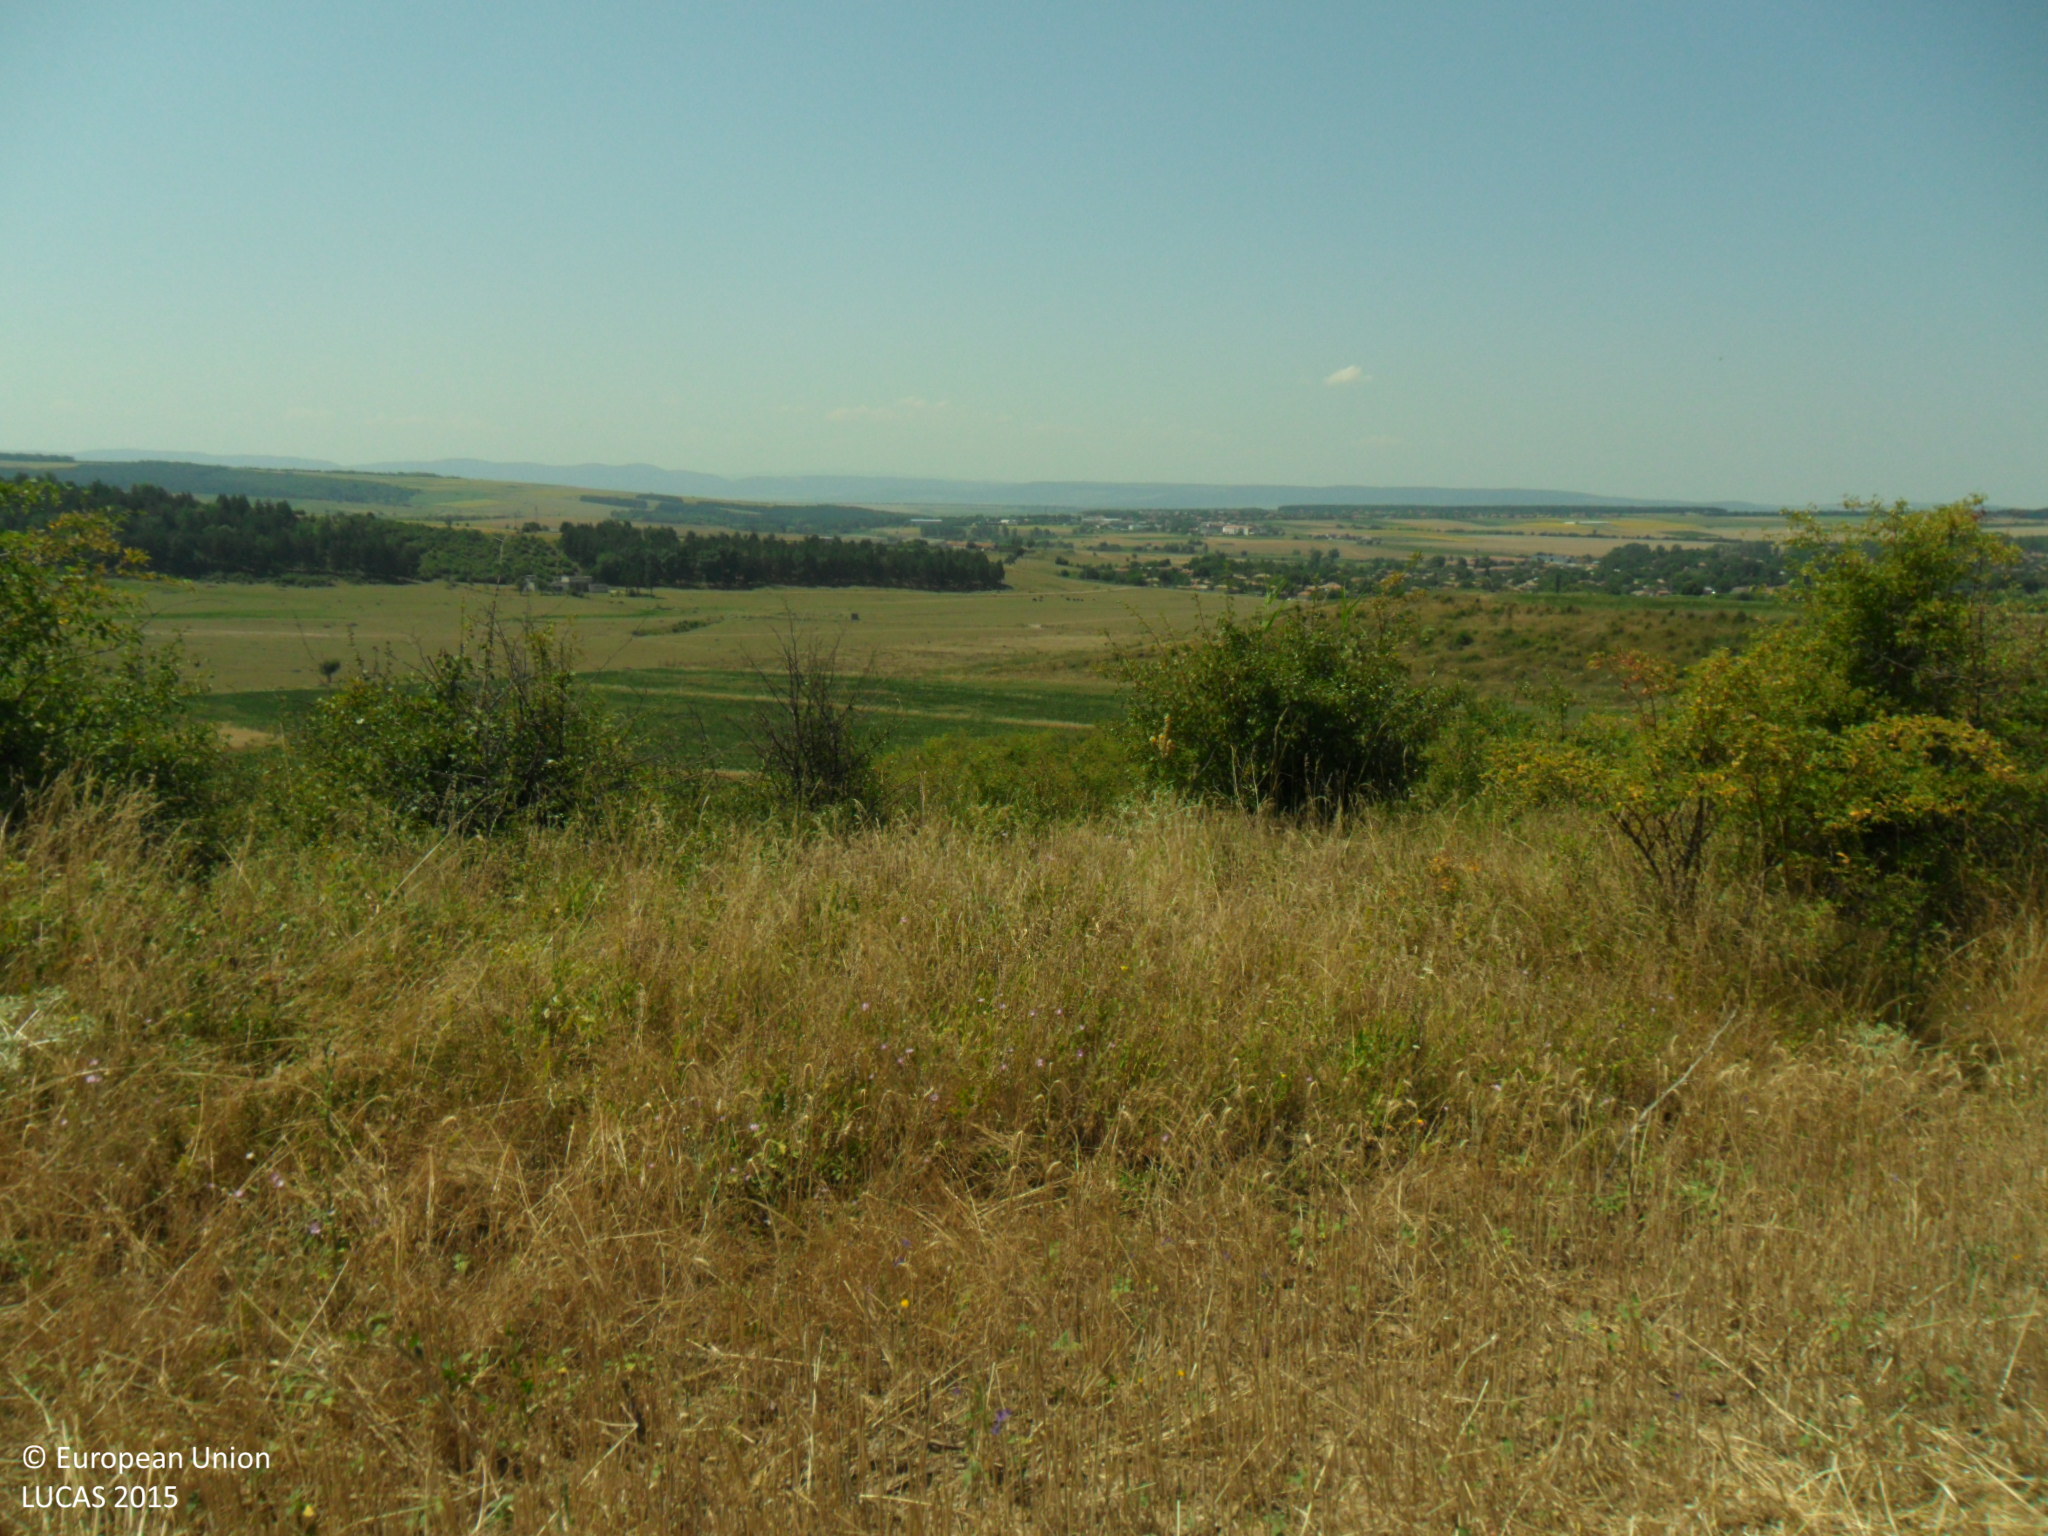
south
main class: Cropland
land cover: Common wheat
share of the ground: 50 - 75 %
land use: Agriculture (excluding fallow land and kitchen gardens)
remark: Harvested field
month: July
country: BG
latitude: 43.4001
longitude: 26.6397
